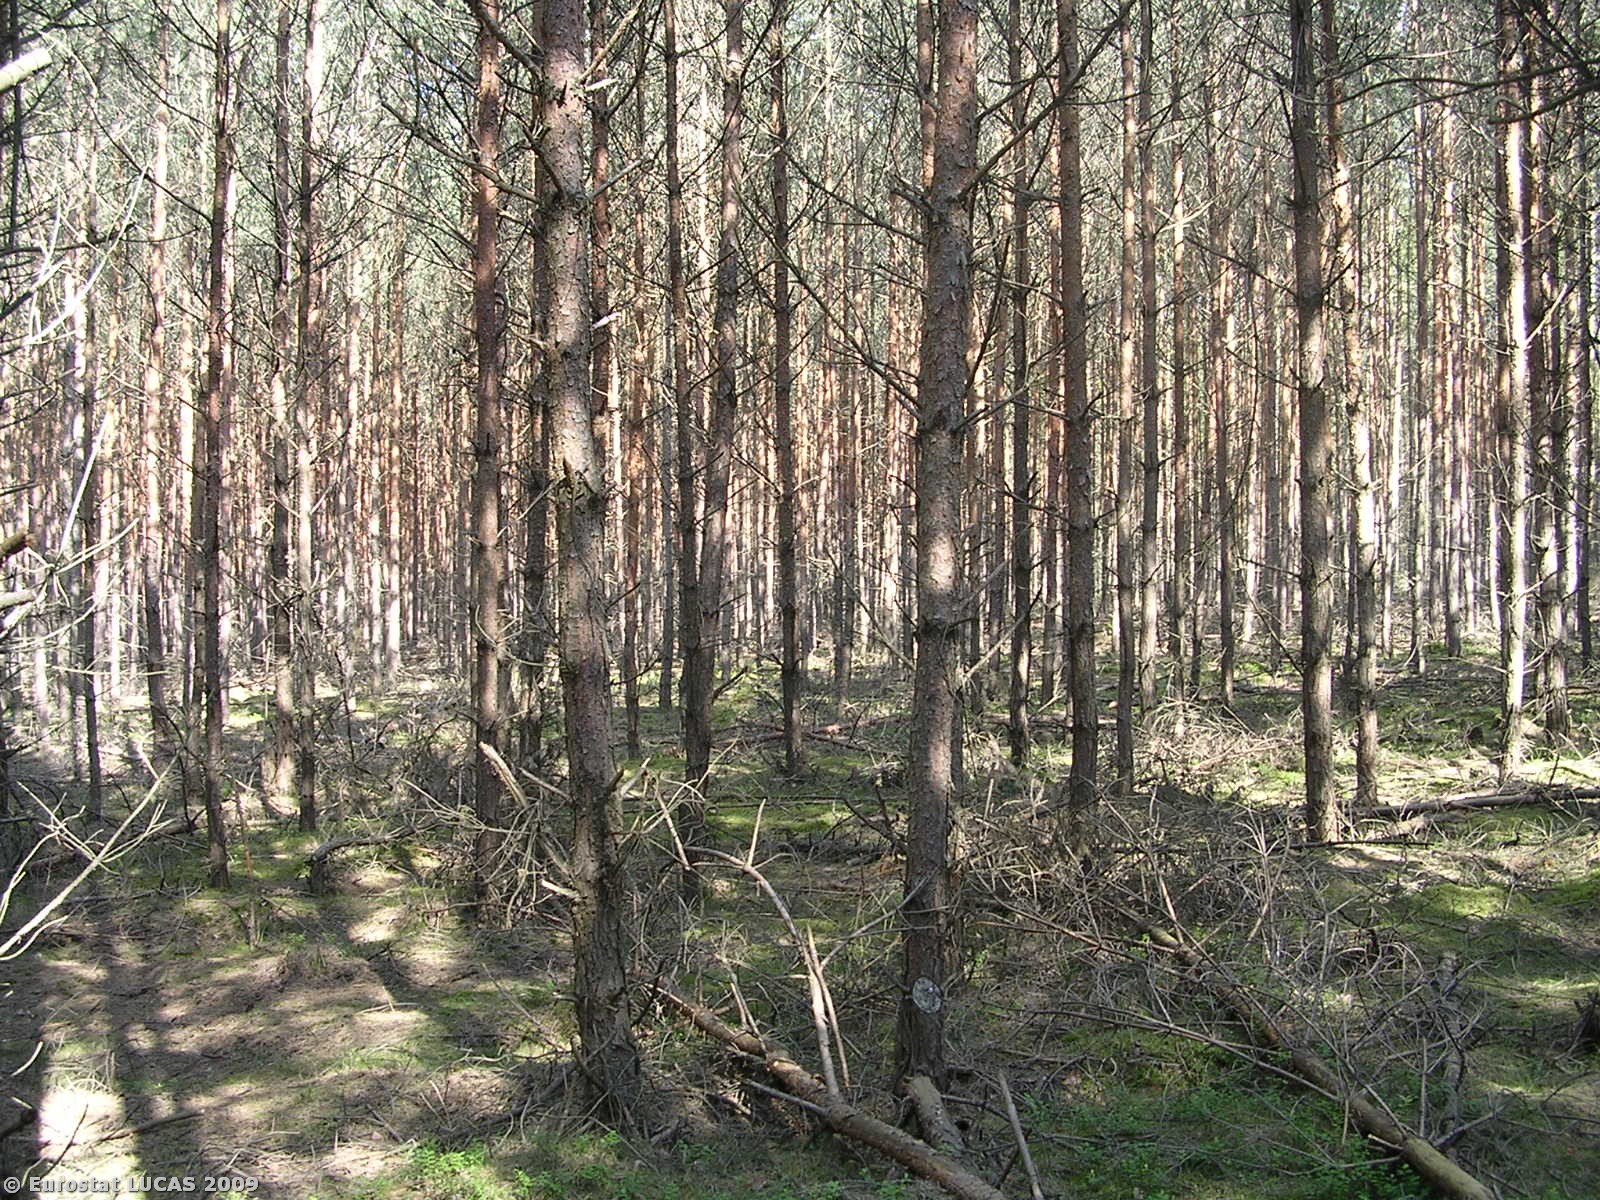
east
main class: Woodland
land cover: Coniferous woodland
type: hemiboreal forest and nemoral coniferous forest and mixed broadleaved-coniferous forest
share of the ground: > 75 %
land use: Forestry
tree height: > 5 m
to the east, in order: Coniferous woodland; Tracks; Coniferous woodland; Tracks; Coniferous woodland
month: June
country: CZ
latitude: 50.6296
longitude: 14.6532
